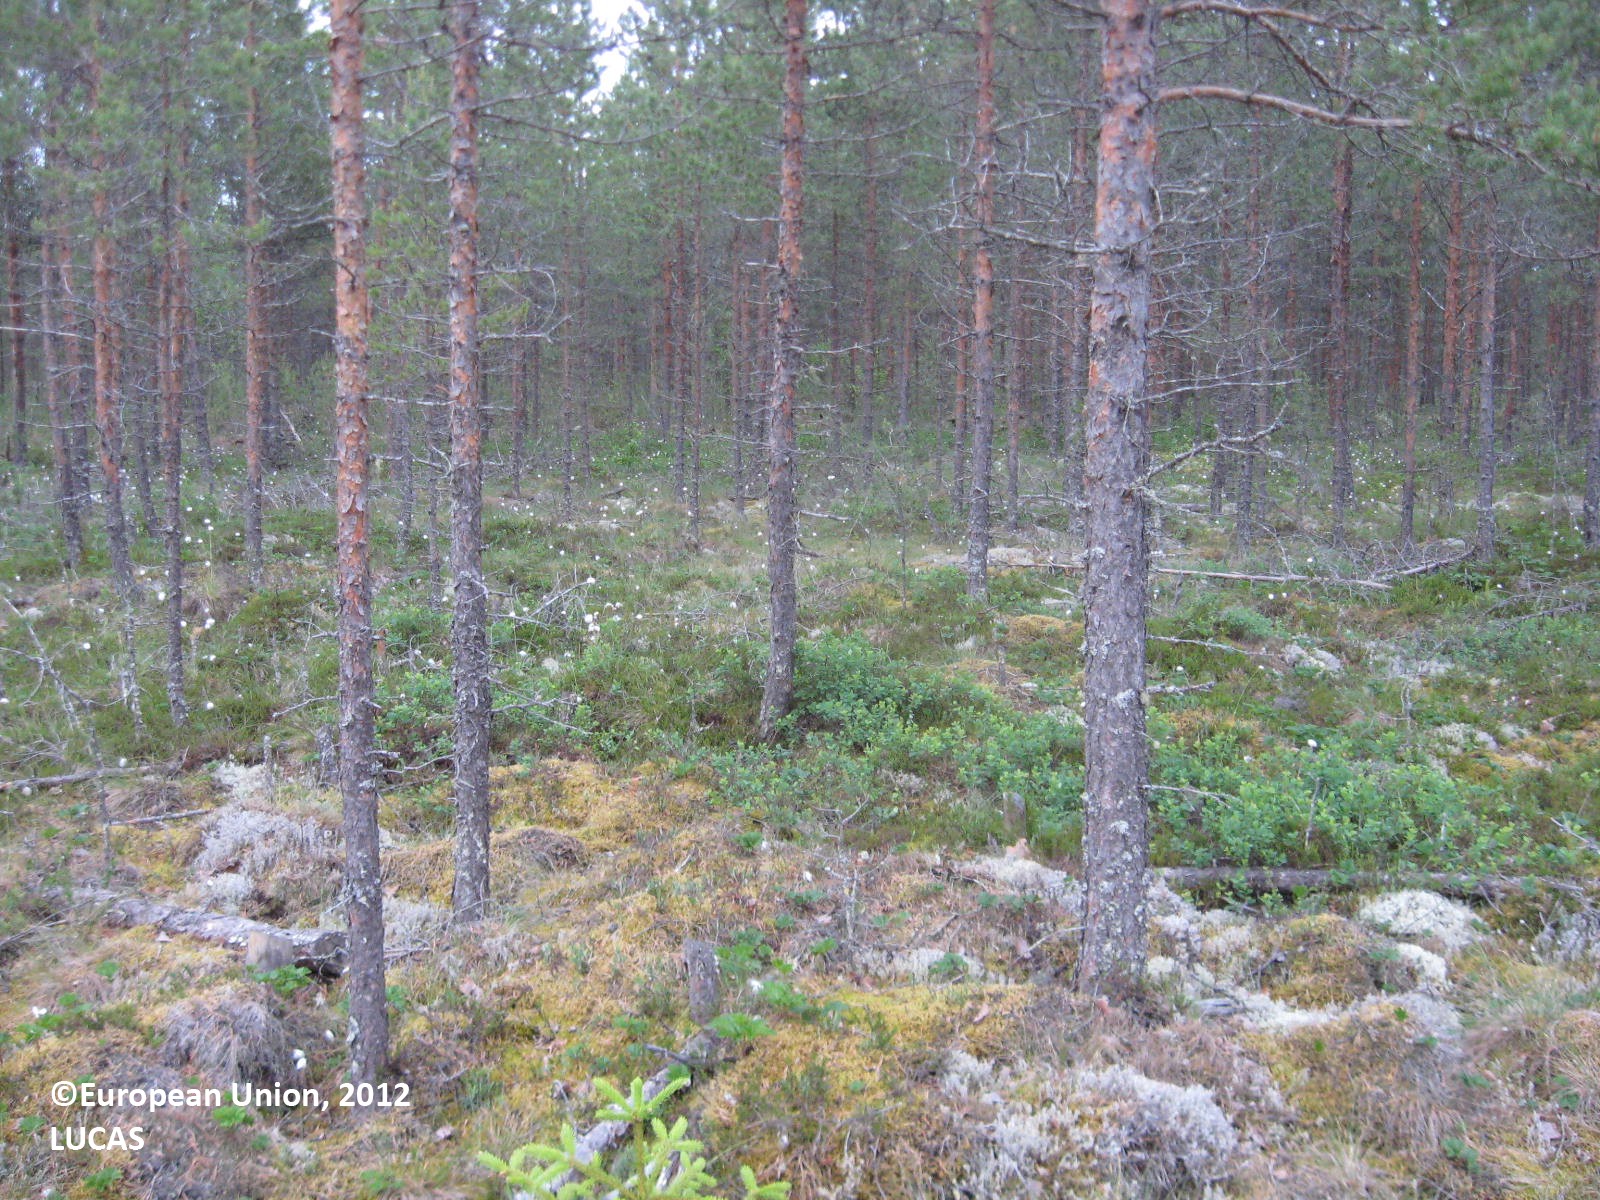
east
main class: Woodland
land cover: Pine dominated coniferous woodland
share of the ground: > 75 %
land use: Forestry
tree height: < 5 m
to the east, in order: Pine dominated coniferous woodland; Ditches and canals; Pine dominated coniferous woodland; Ditches and canals; Pine dominated coniferous woodland; Ditches and canals; Pine dominated coniferous woodland; Ditches and canals; Pine dominated coniferous woodland; Ditches and canals; Pine dominated mixed woodland
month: June
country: FI
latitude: 62.8987
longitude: 22.6668
